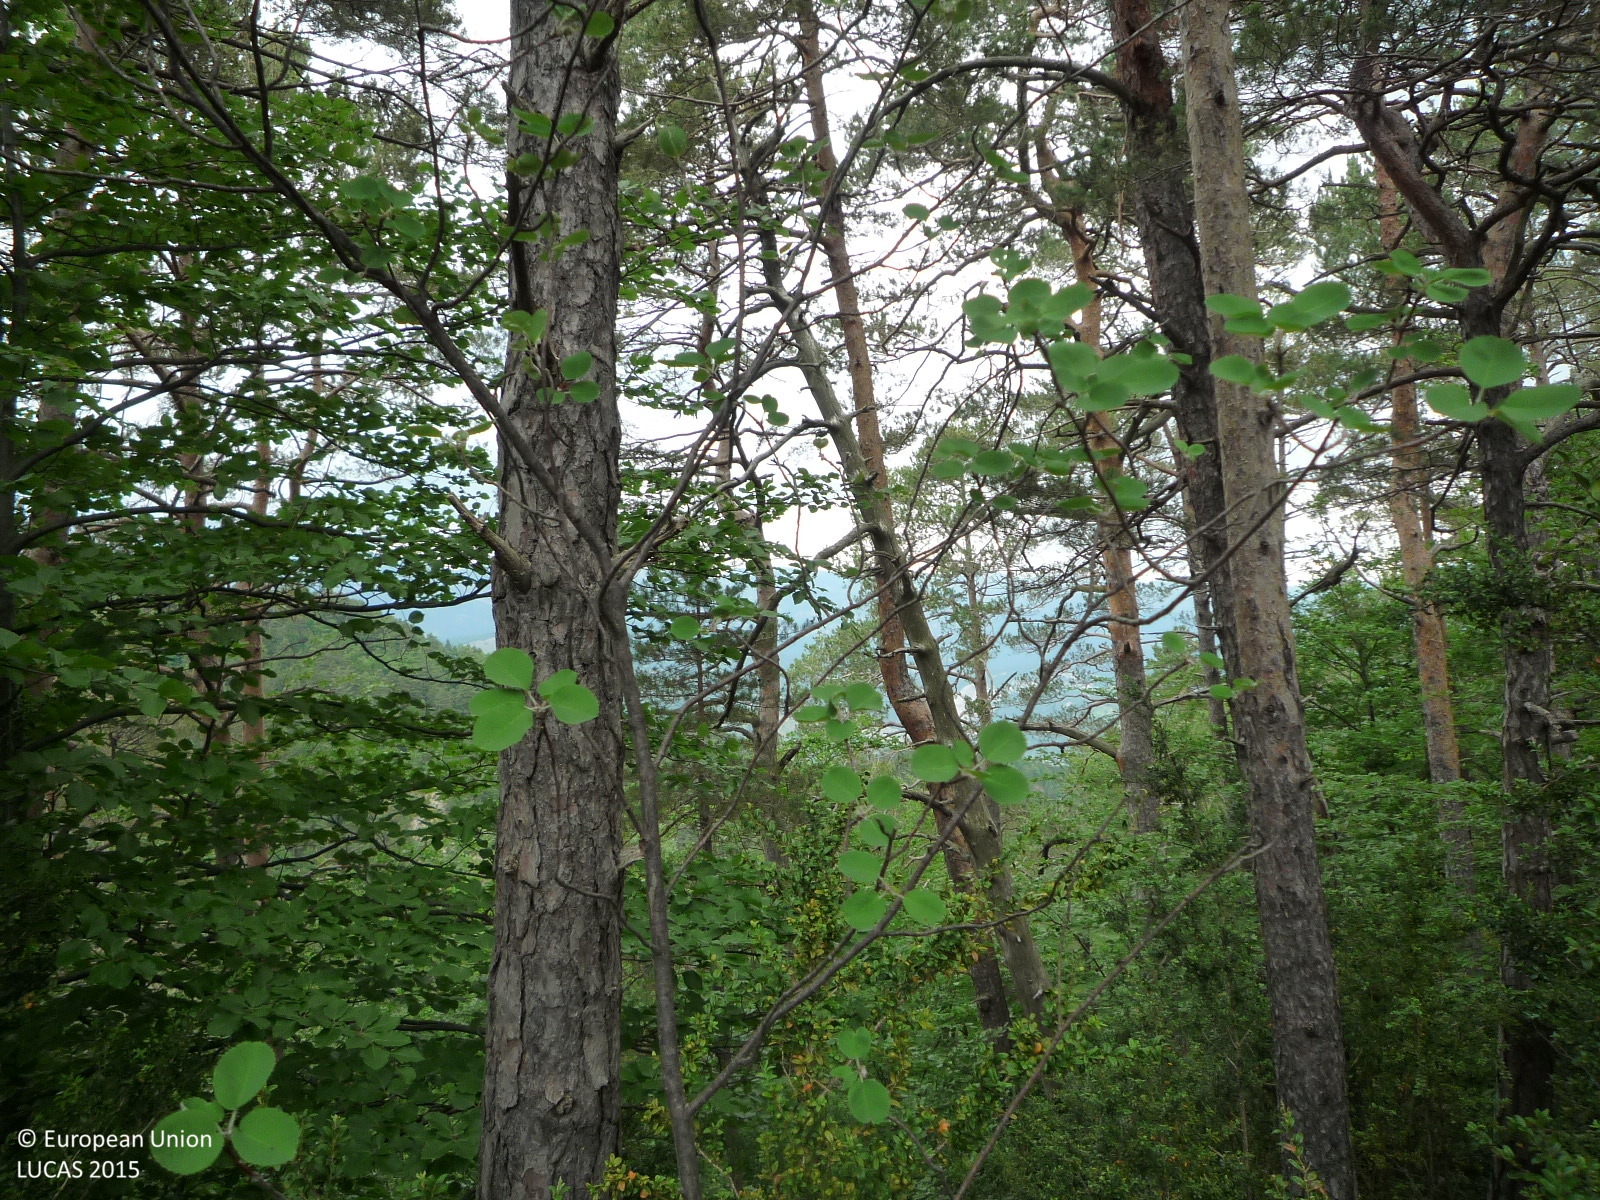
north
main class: Woodland
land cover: Pine dominated mixed woodland
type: alpine coniferous forest
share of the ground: > 75 %
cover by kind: coniferous forest trees 60 %, broadleaved forest trees 20 %, consolidated bare surface 20 %
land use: Forestry
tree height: > 5 m
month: June
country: ES
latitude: 42.2248
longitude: 1.9556
